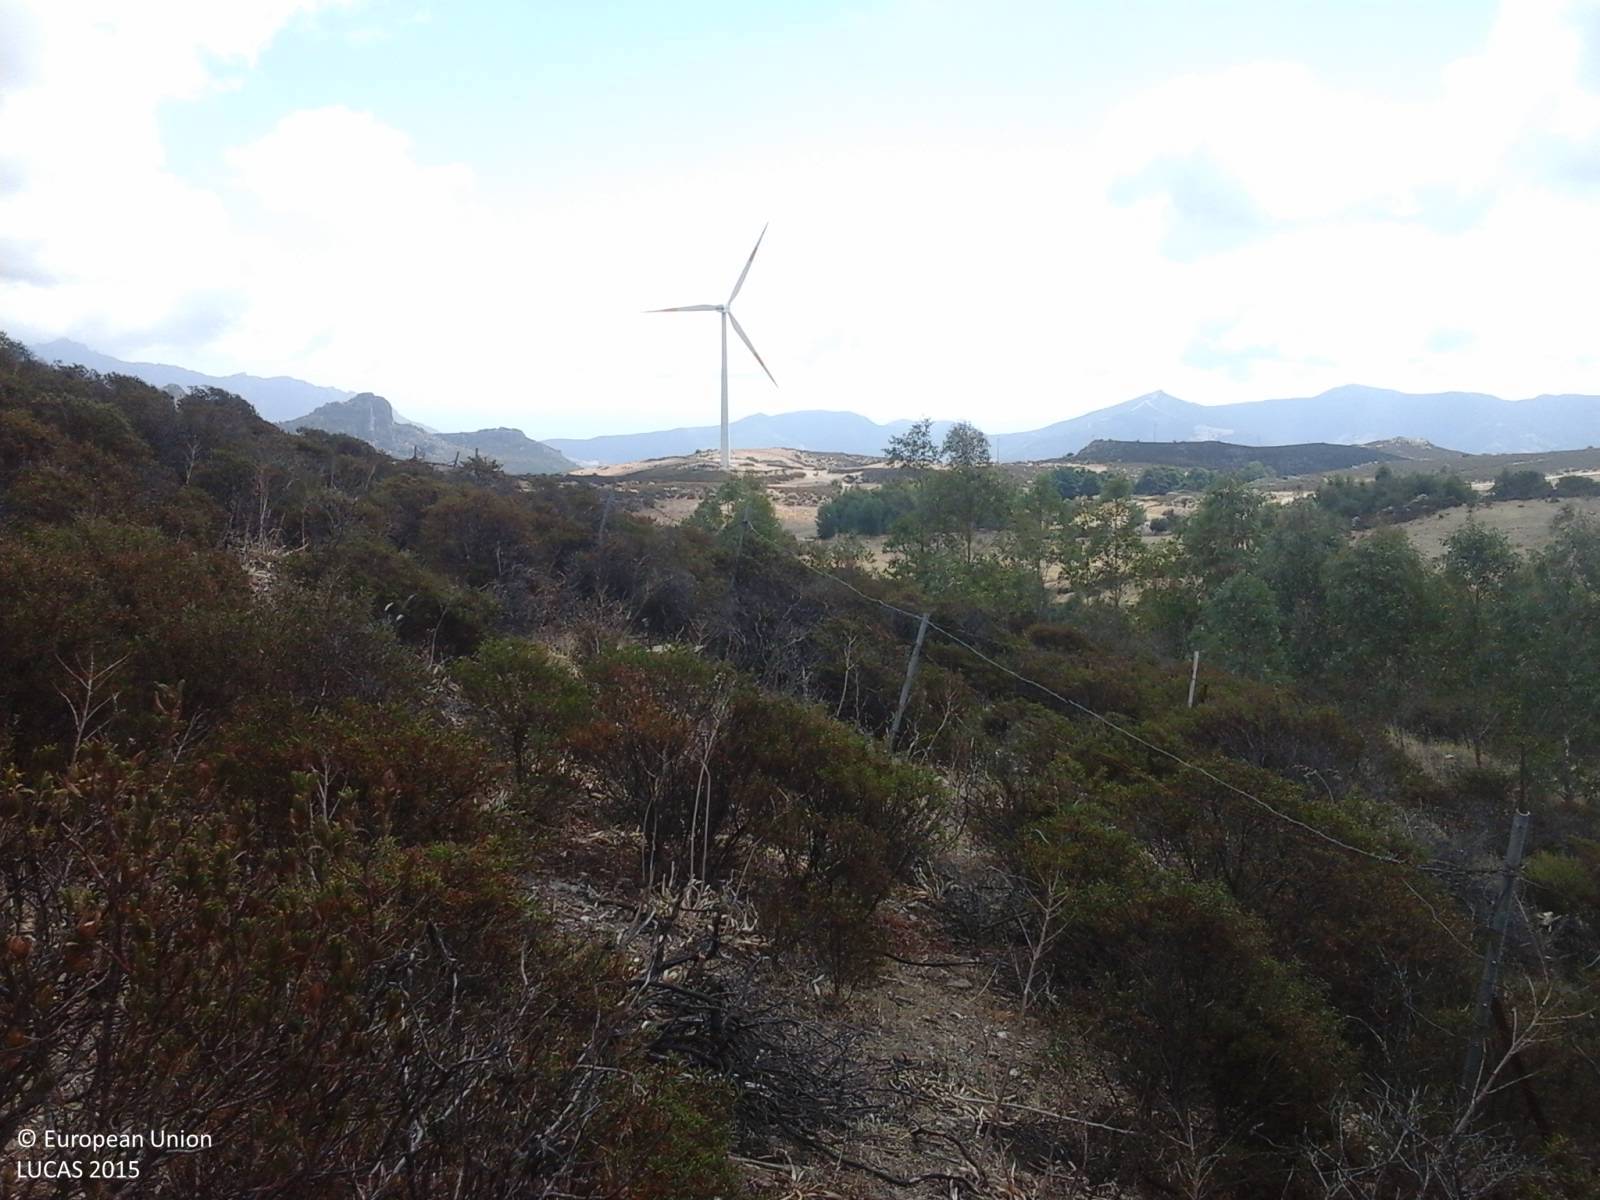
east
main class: Shrubland
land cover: Shrubland without tree cover
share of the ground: > 75 %
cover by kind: shrubs 80 %, herbaceous plants 10 %, unconsolidated bare surface 10 %
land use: Agriculture (excluding fallow land and kitchen gardens)
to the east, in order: Shrubland without tree cover; Fences; Shrubland without tree cover; Grassland without tree/shrub cover
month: August
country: IT
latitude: 39.7048
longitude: 9.5246
